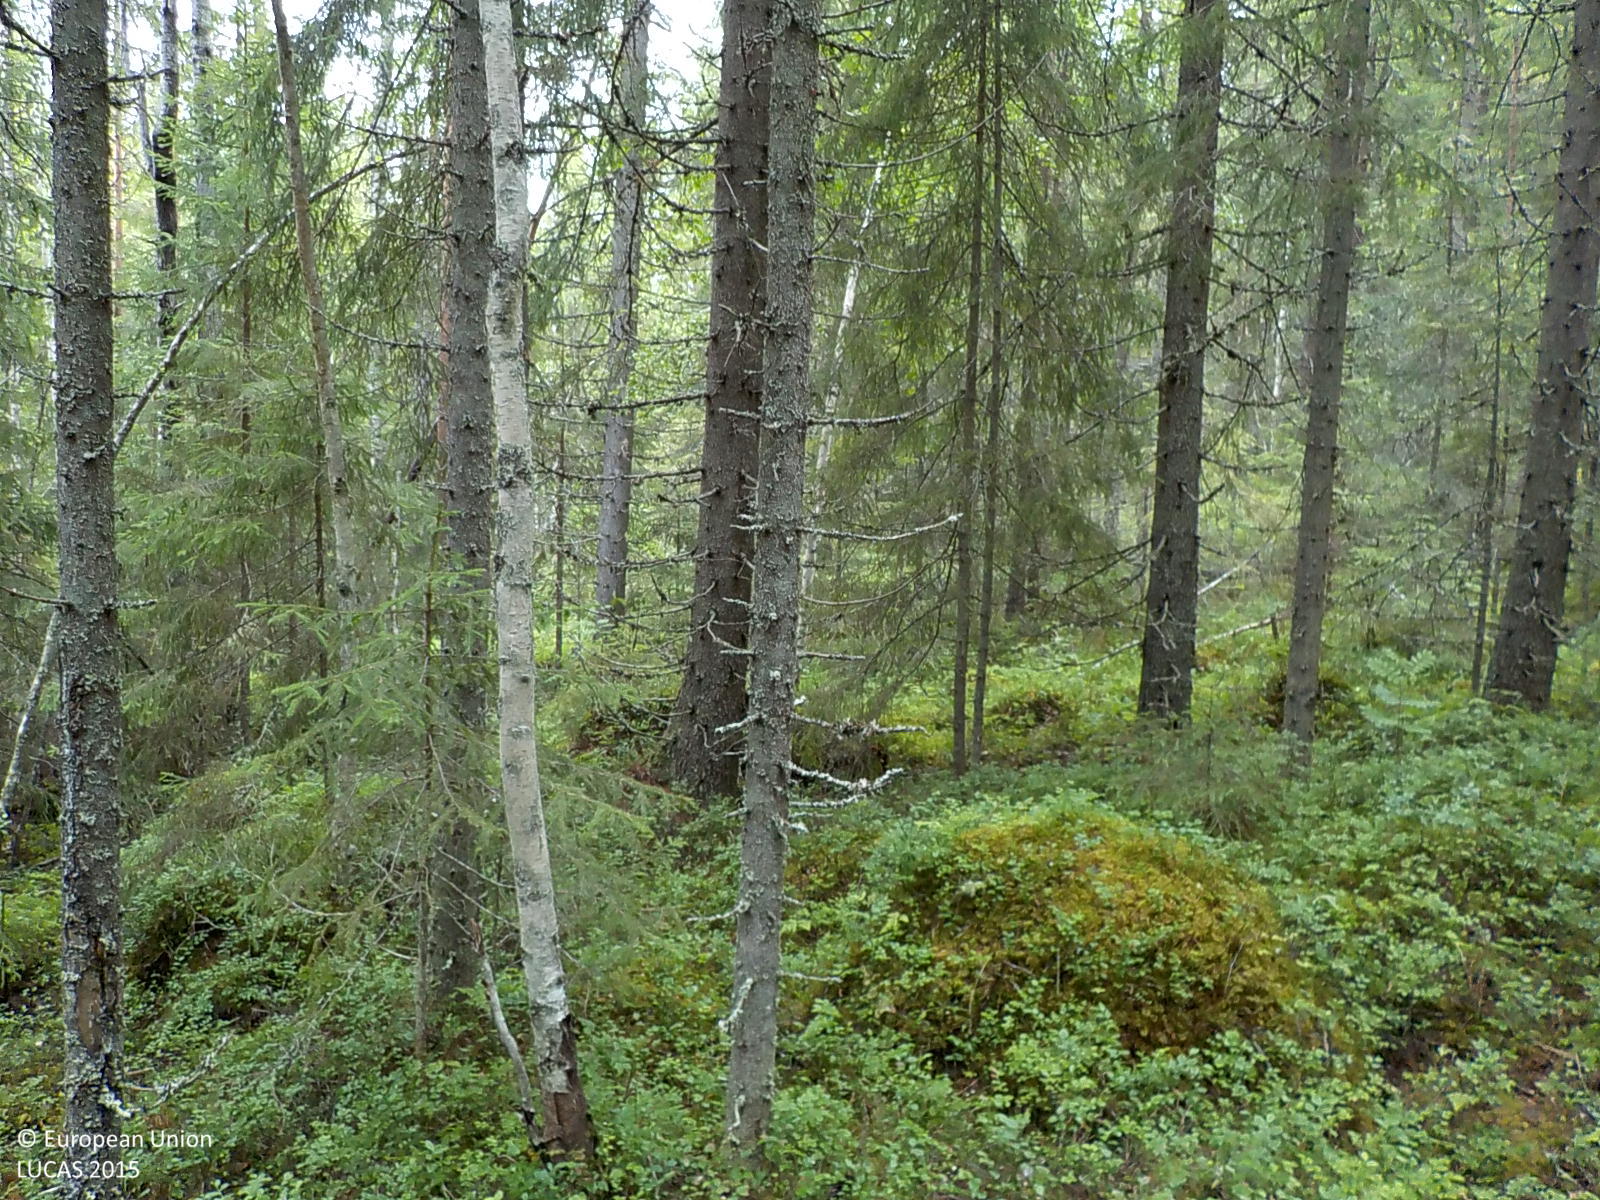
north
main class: Woodland
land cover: Spruce dominated coniferous woodland
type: boreal forest
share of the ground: 50 - 75 %
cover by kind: coniferous forest trees 60 %, shrubs 25 %, lichens and mosses 15 %
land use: Forestry
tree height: > 5 m
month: July
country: SE
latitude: 63.3090
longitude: 17.2185
